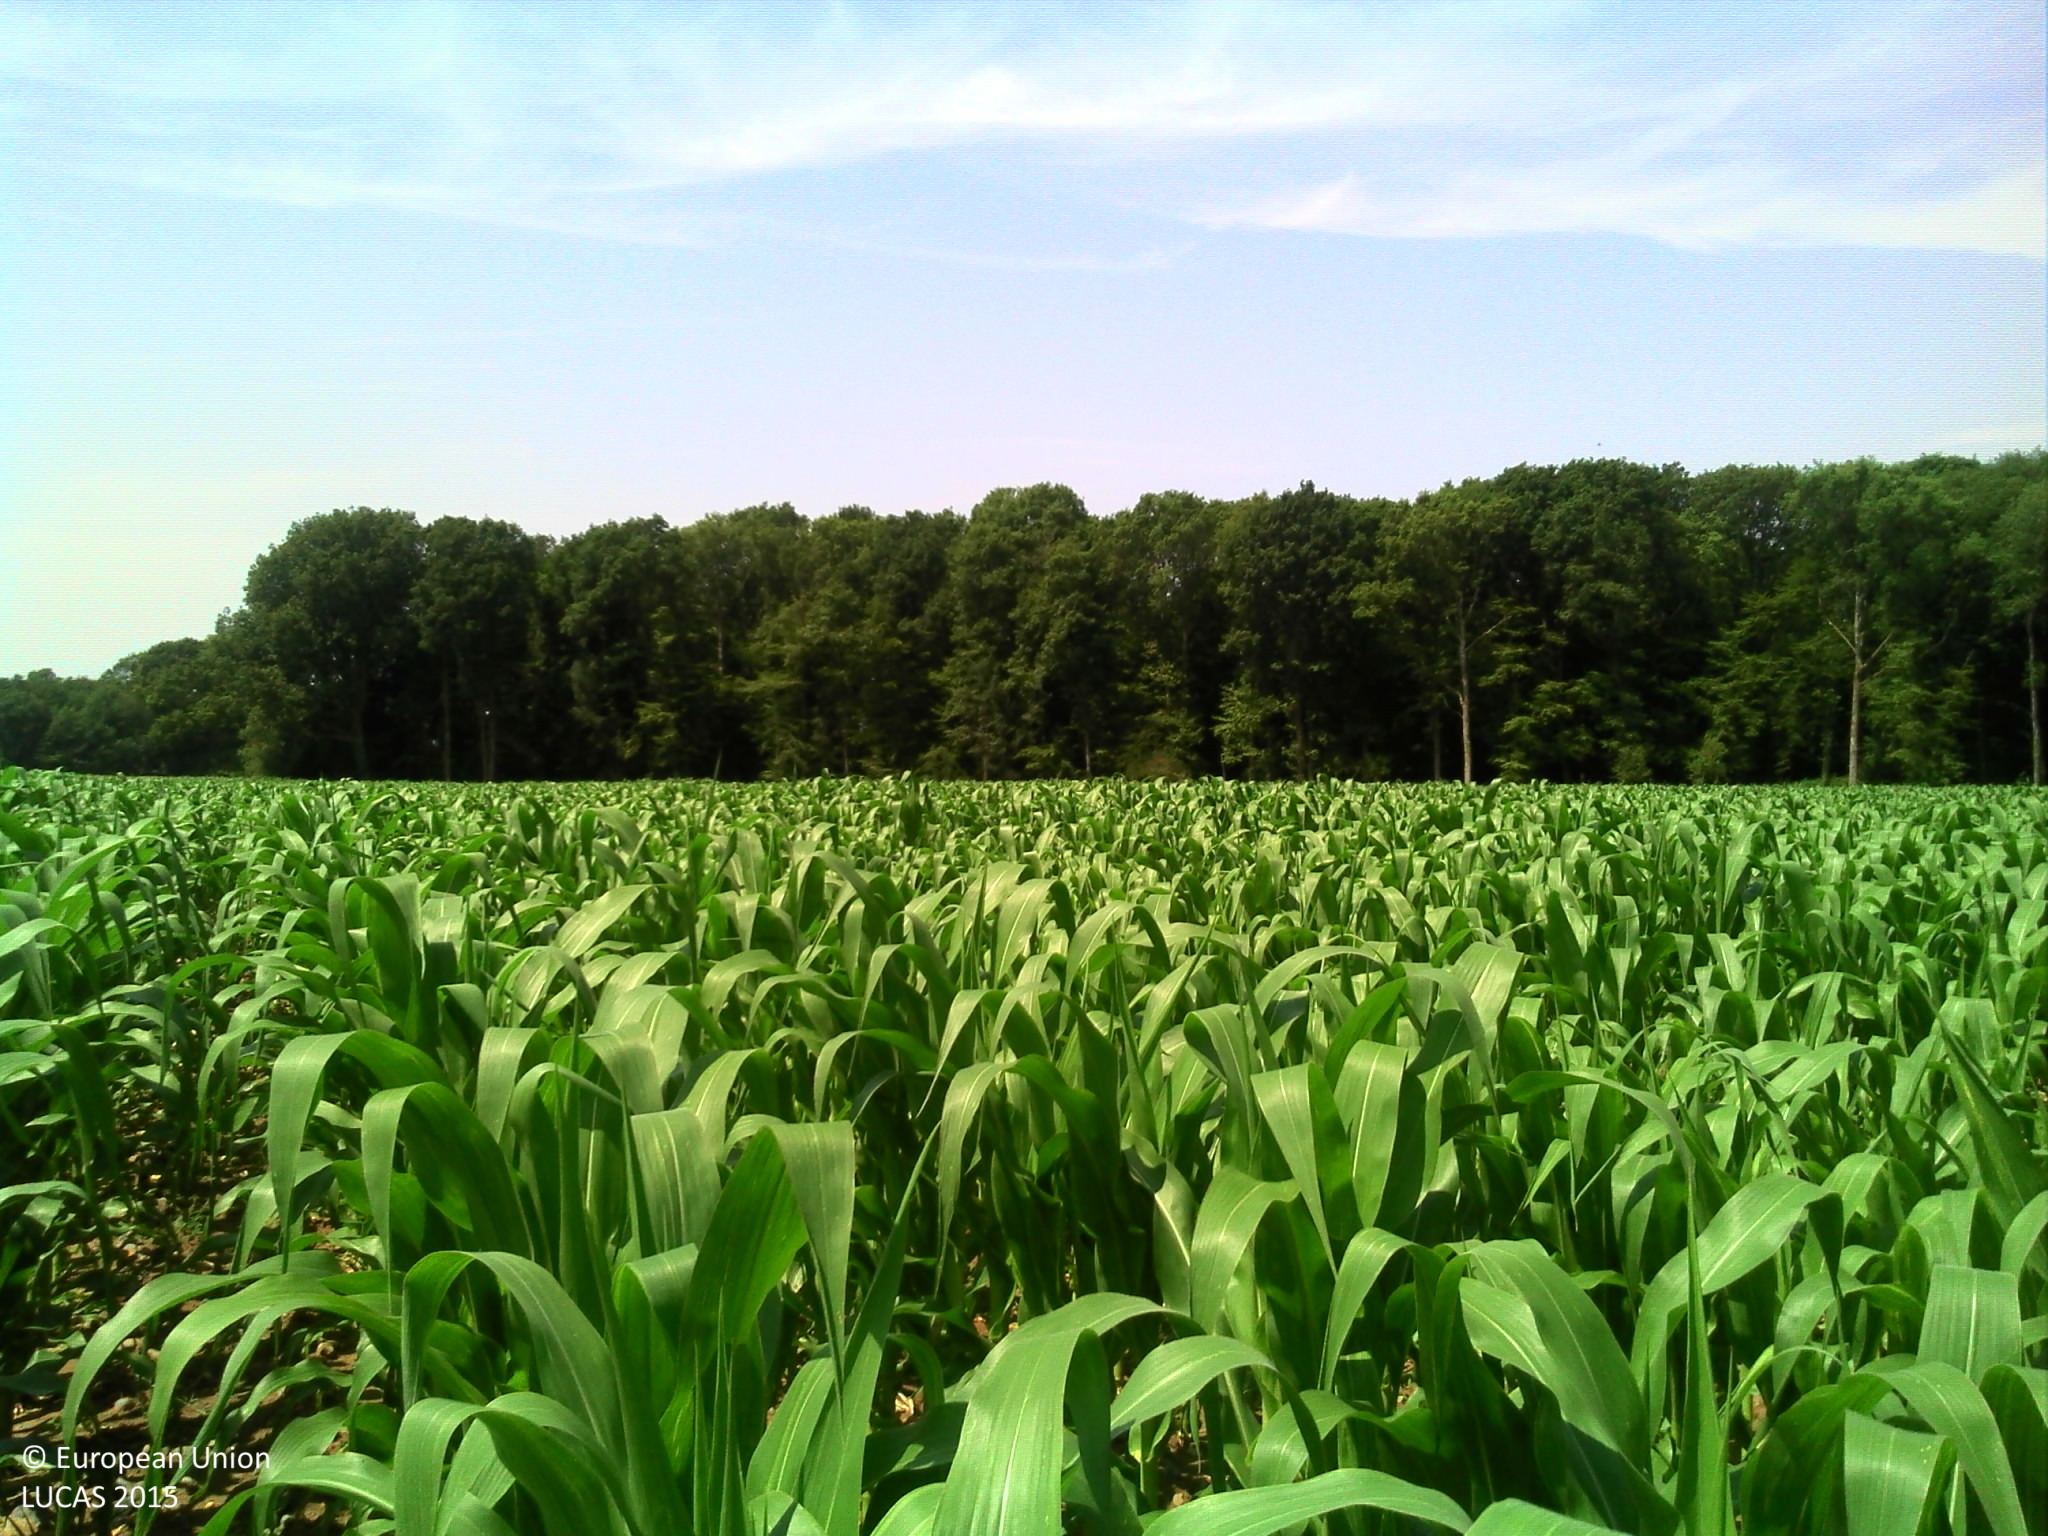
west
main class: Cropland
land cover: Maize
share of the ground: > 75 %
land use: Agriculture (excluding fallow land and kitchen gardens)
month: July
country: FR
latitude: 47.7747
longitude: 2.8534
